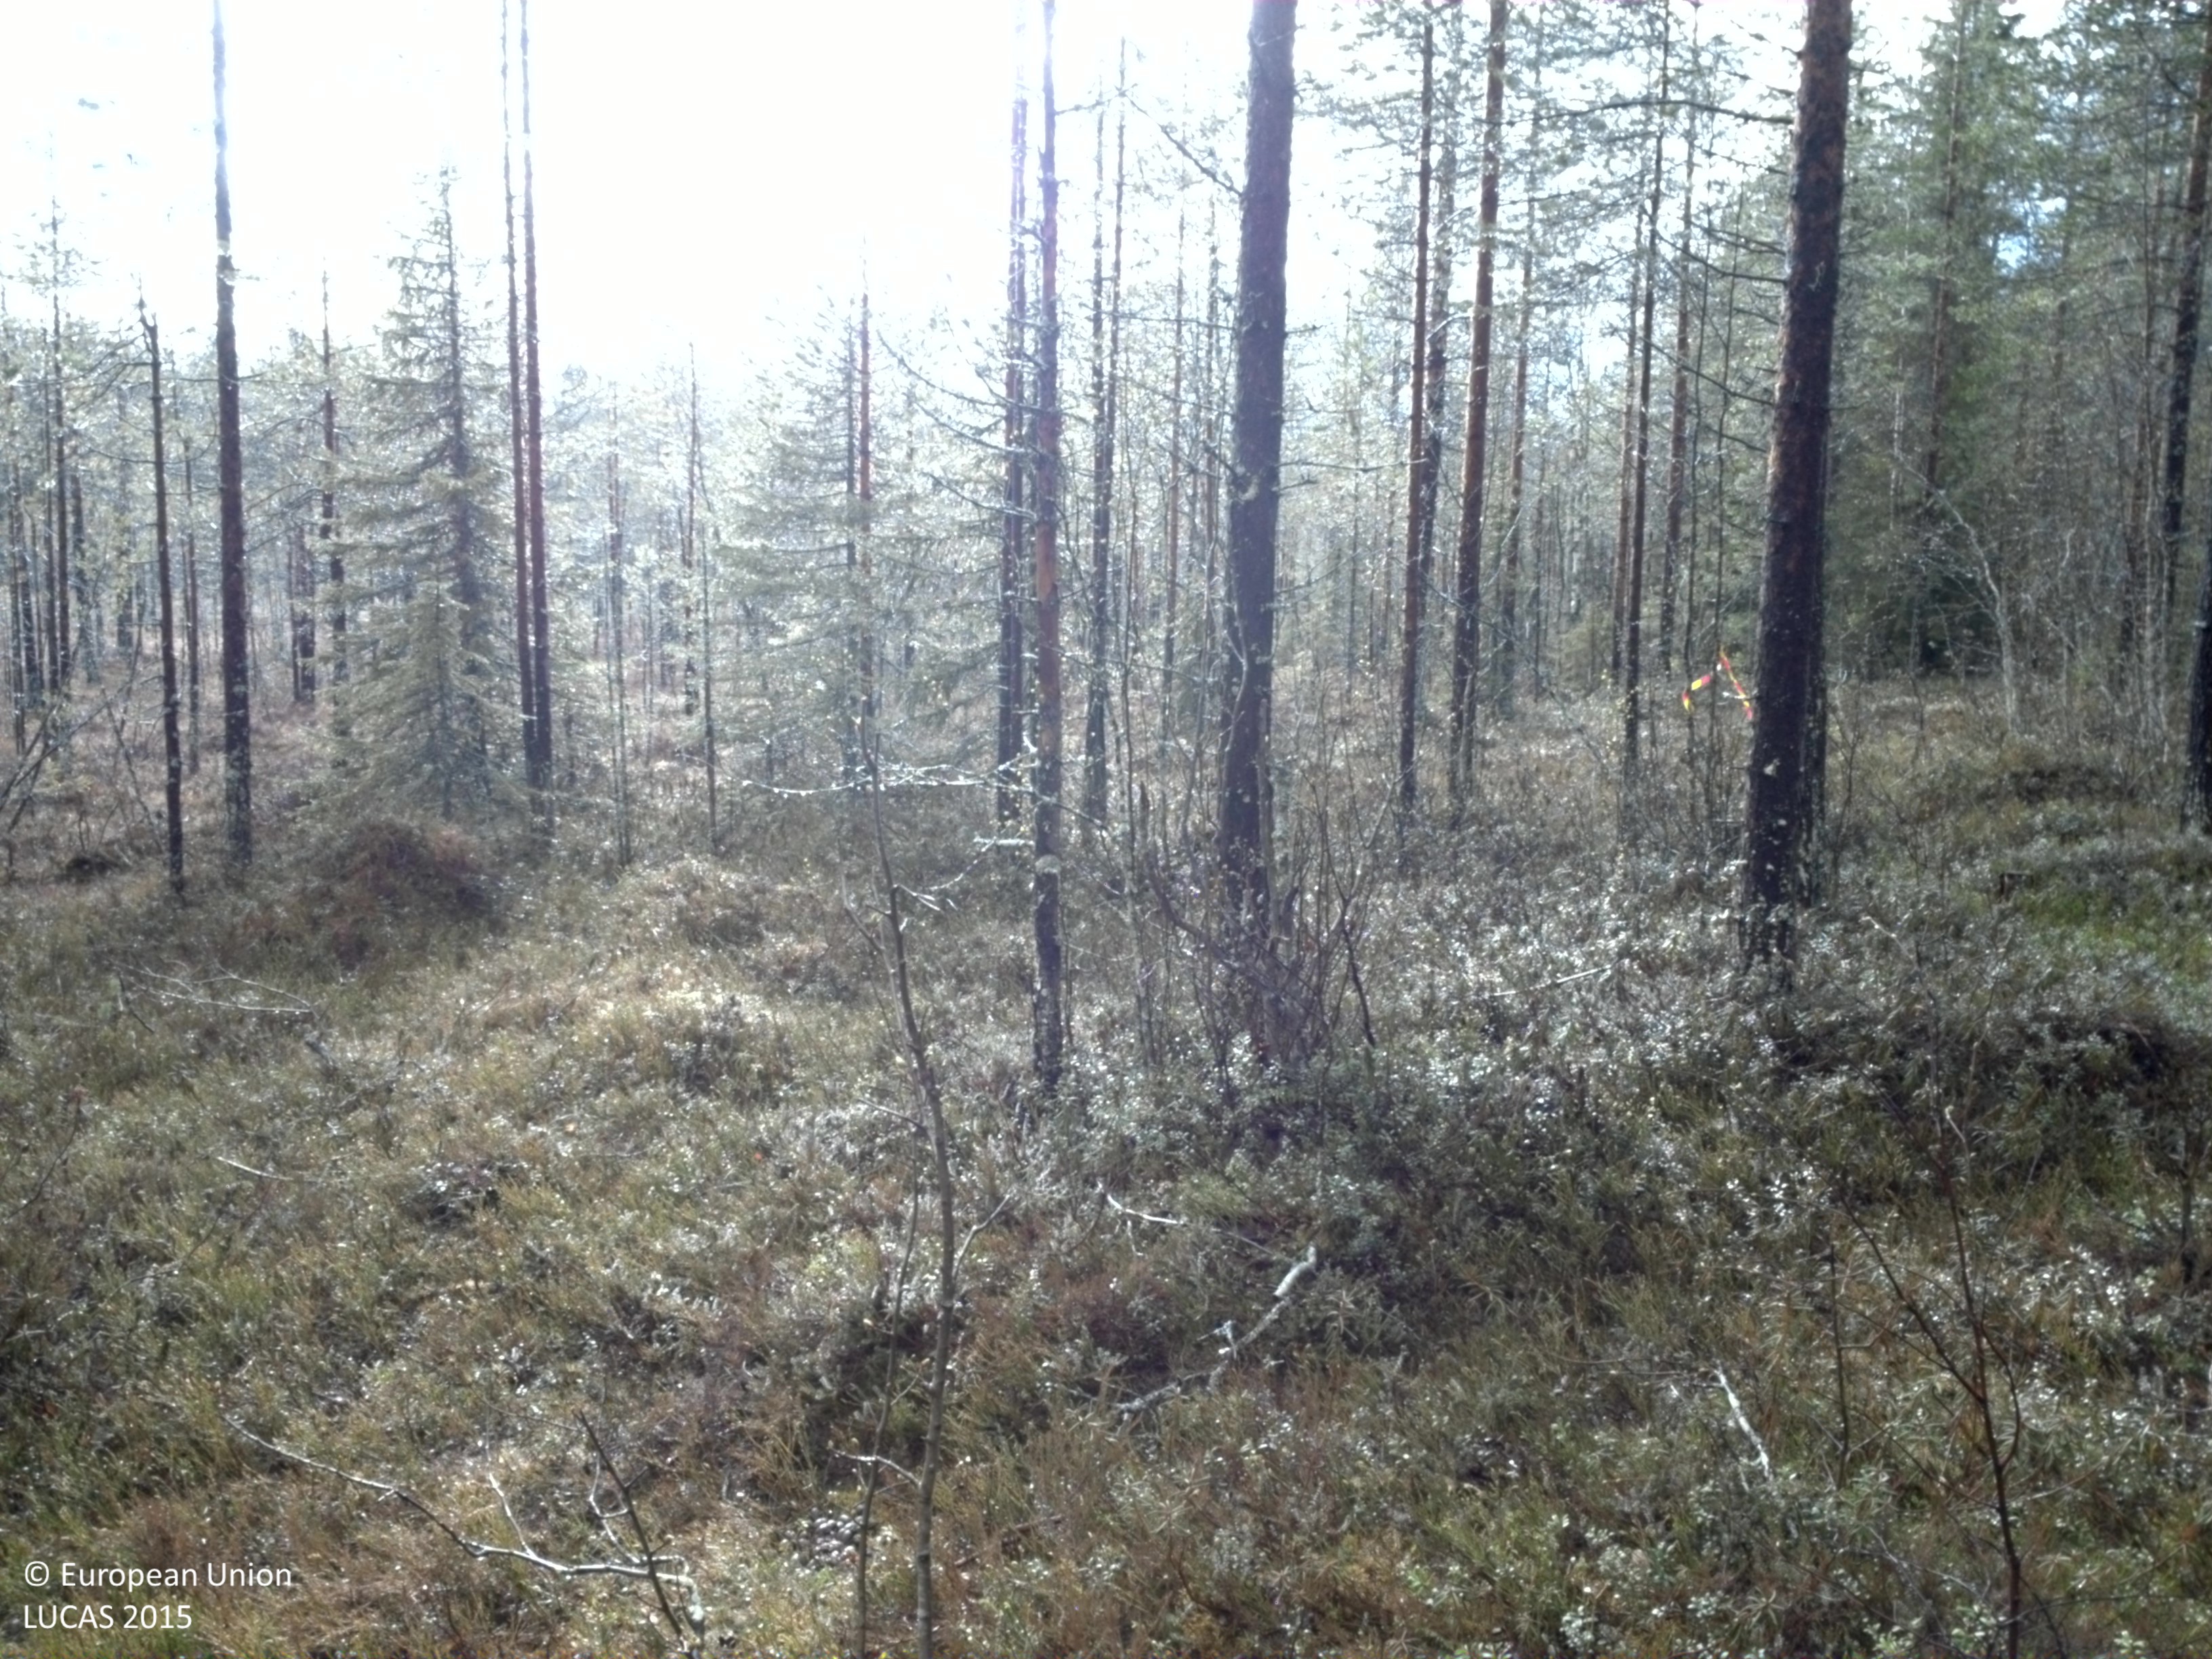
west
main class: Woodland
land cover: Pine dominated coniferous woodland
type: boreal forest
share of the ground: > 75 %
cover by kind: coniferous forest trees 85 %, shrubs 15 %
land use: Forestry
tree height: > 5 m
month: May
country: SE
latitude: 66.2927
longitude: 23.1550
